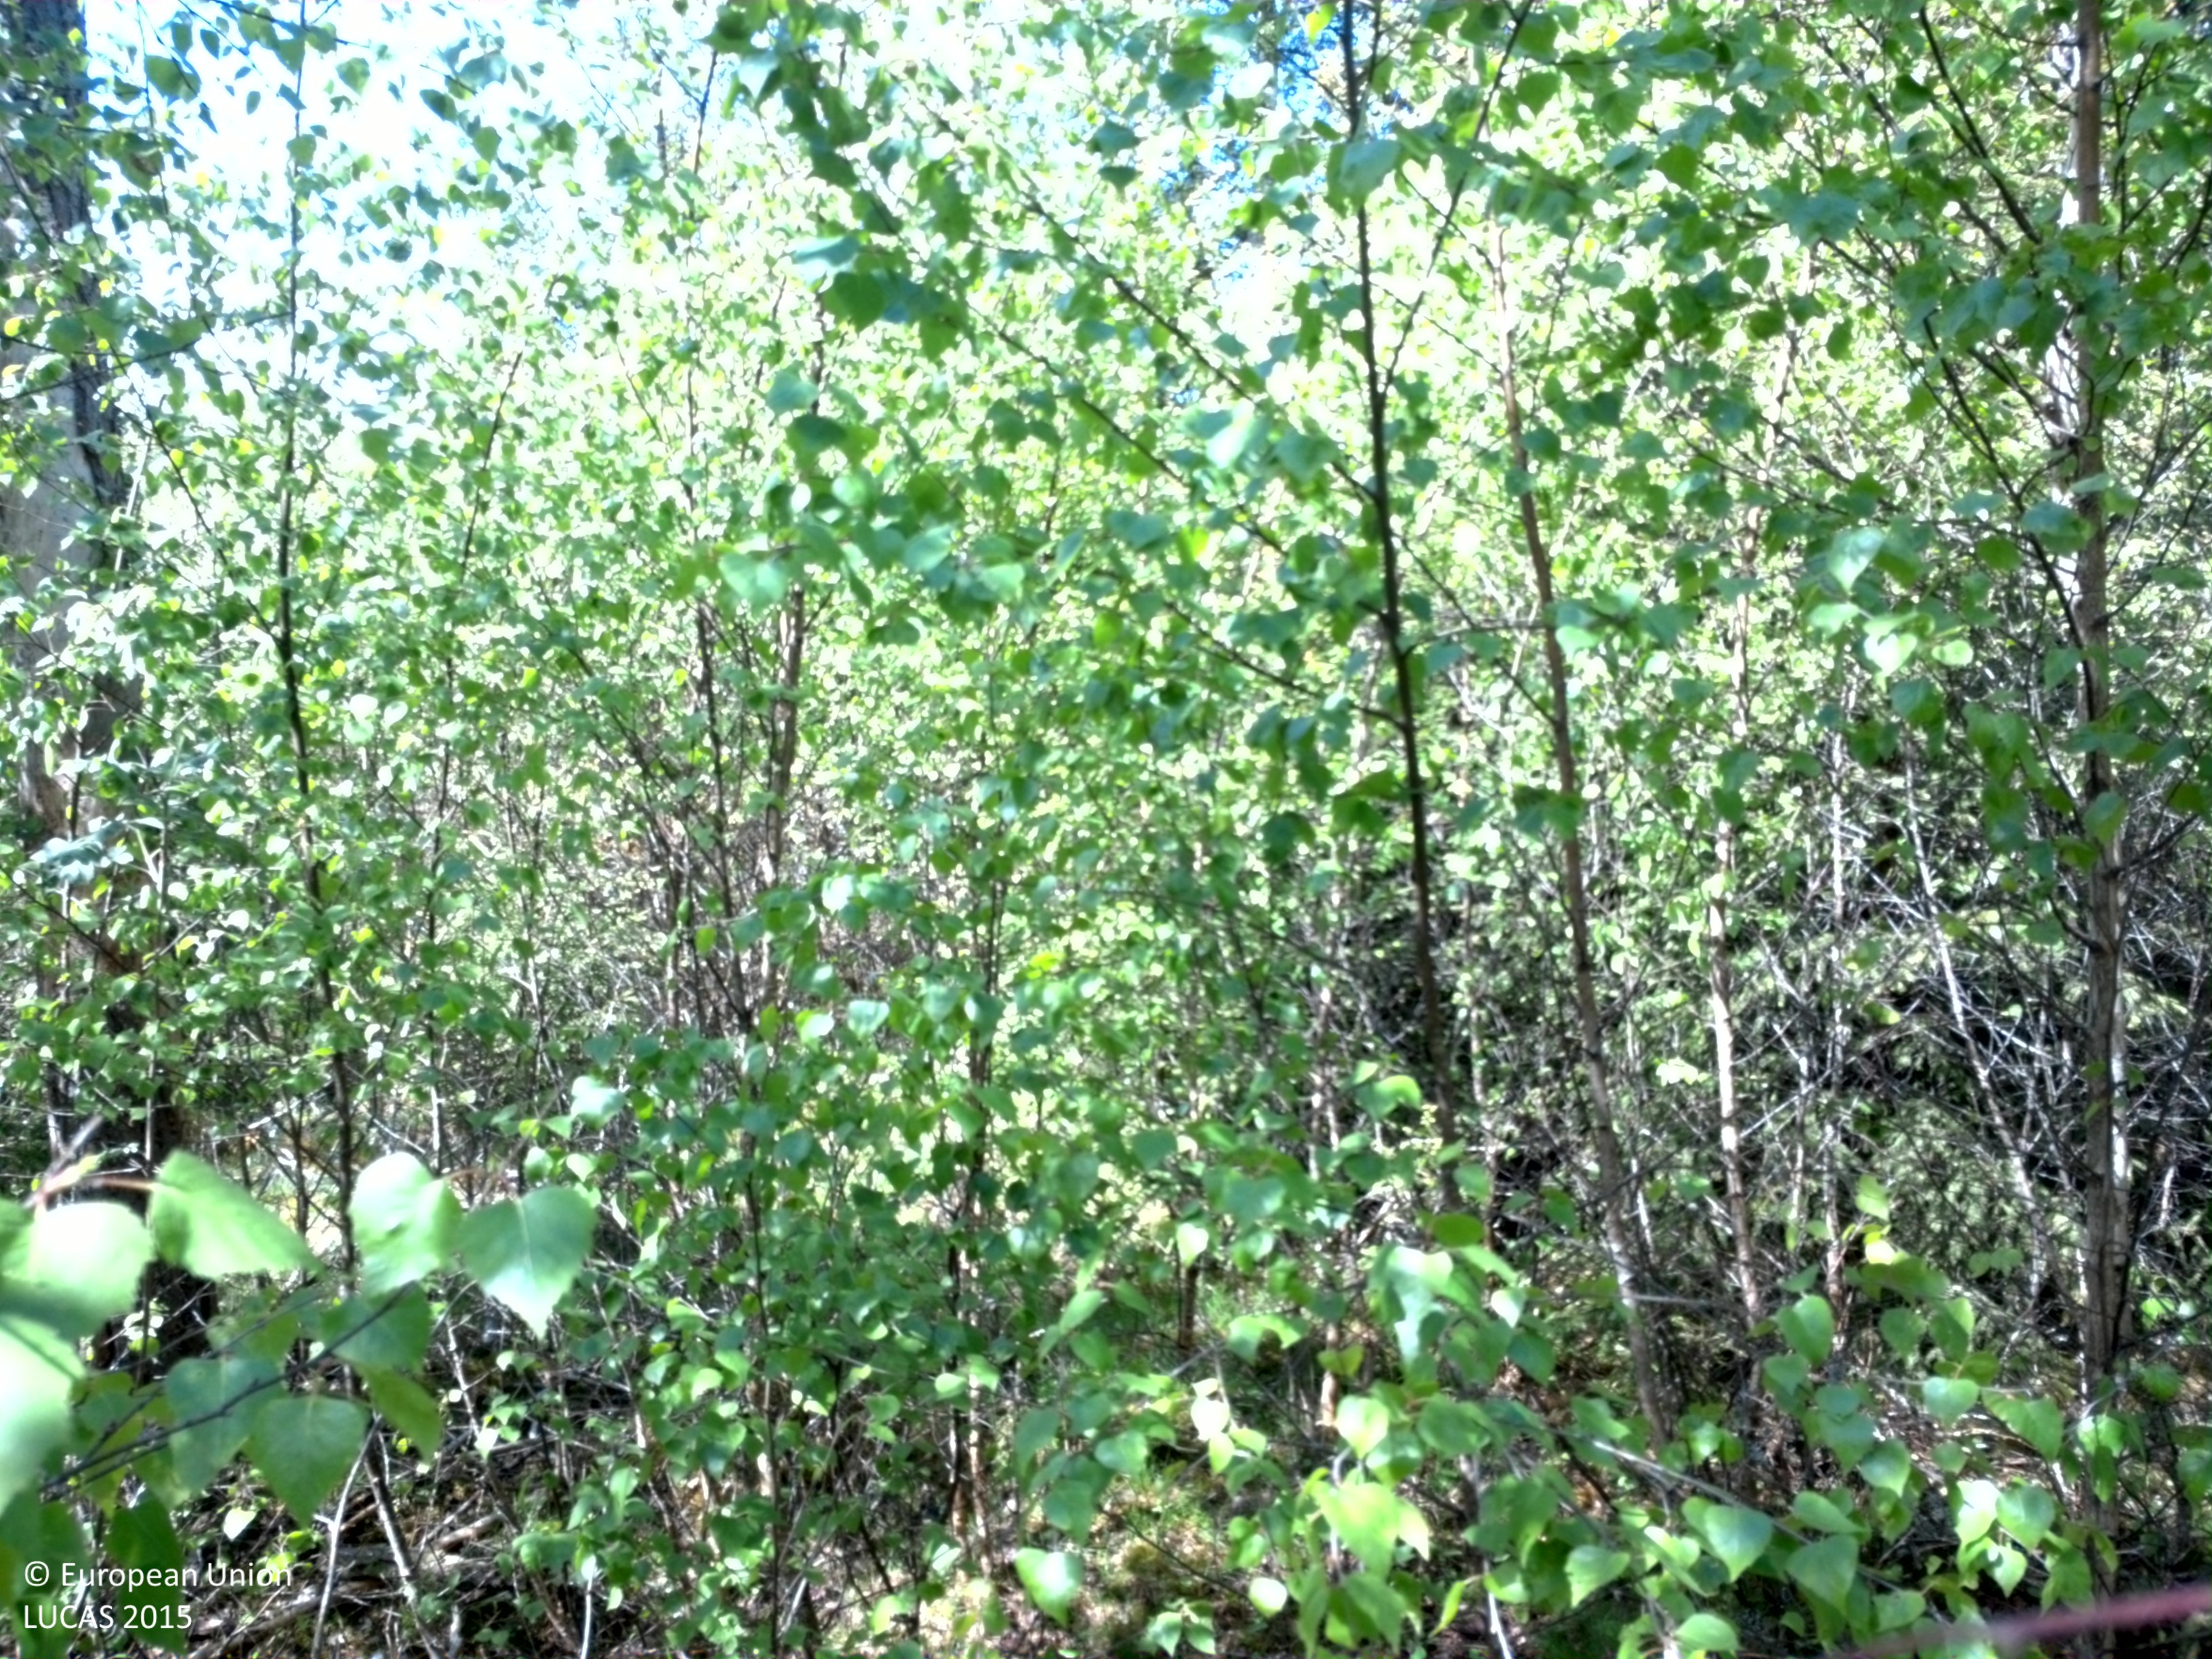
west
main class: Woodland
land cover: Broadleaved woodland
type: boreal forest
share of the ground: > 75 %
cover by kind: broadleaved forest trees 75 %, herbaceous plants 10 %, lichens and mosses 10 %, shrubs 5 %
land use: Forestry
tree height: < 5 m
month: June
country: SE
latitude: 56.7708
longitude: 14.6276
